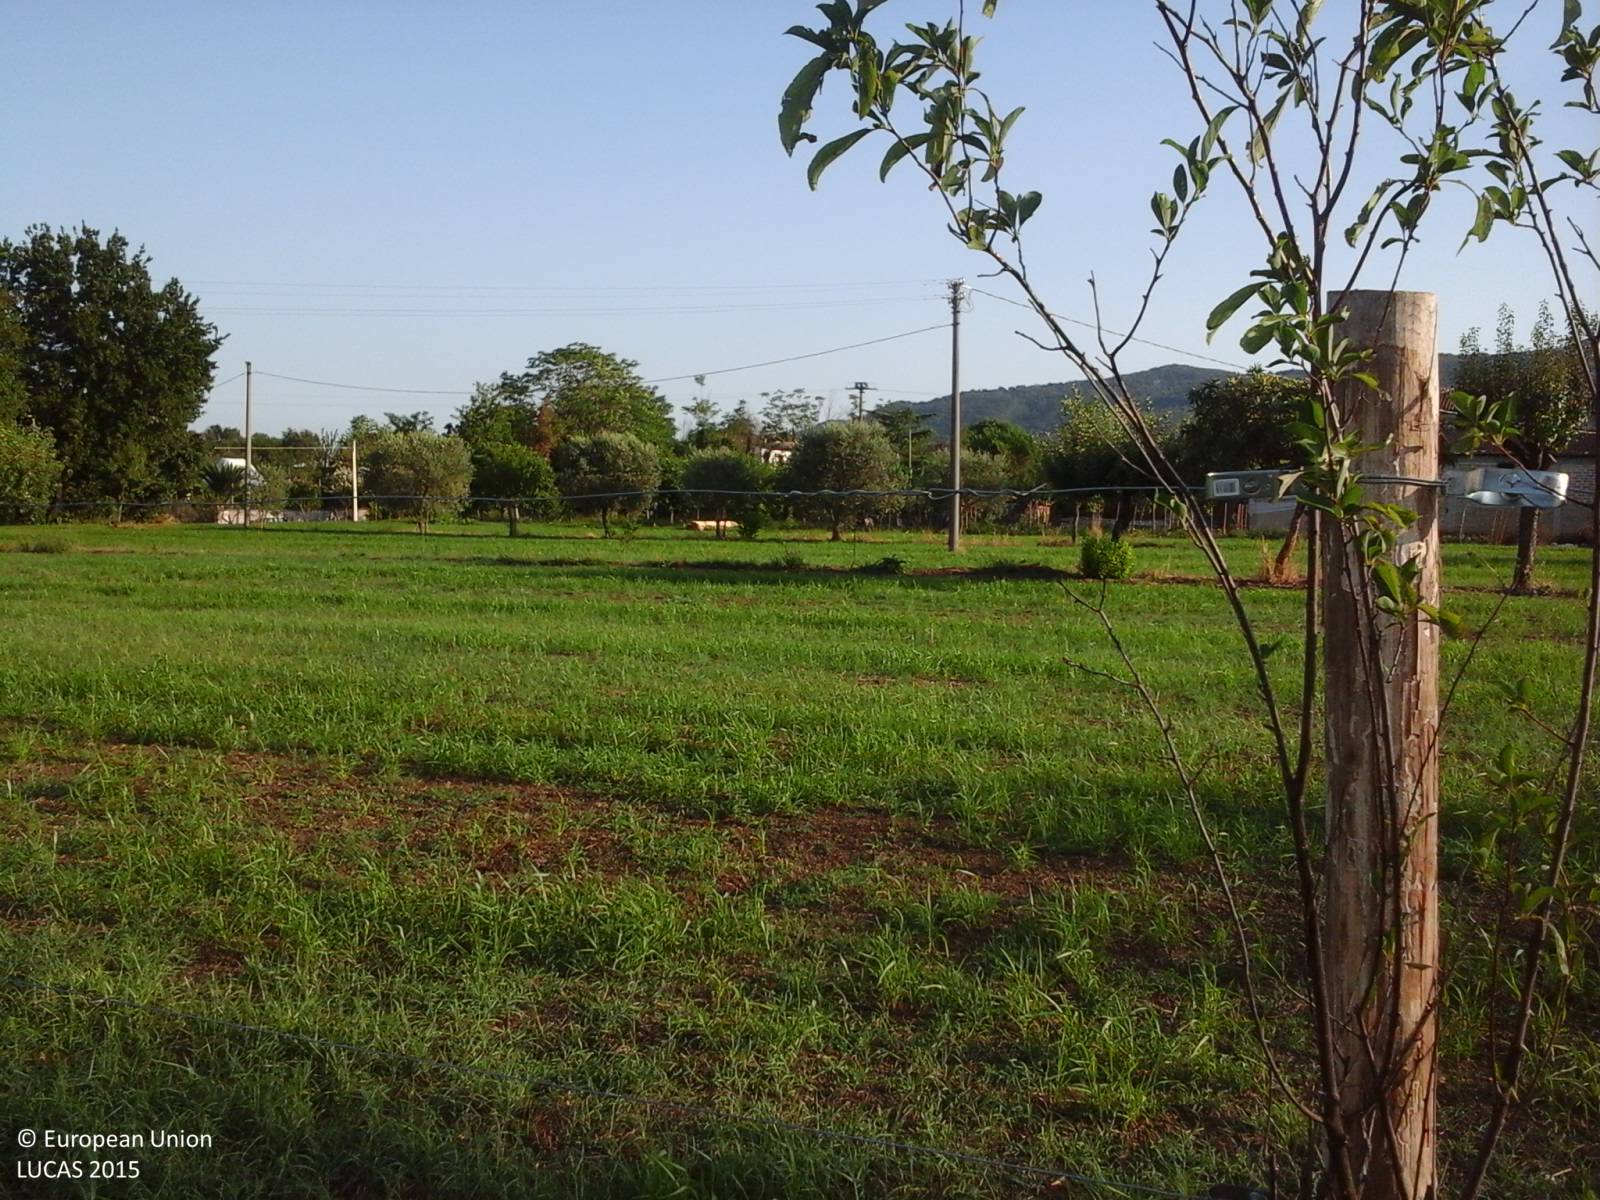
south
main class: Cropland
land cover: Lucerne
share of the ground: > 75 %
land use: Agriculture (excluding fallow land and kitchen gardens)
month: July
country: IT
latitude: 41.2582
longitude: 14.3398
